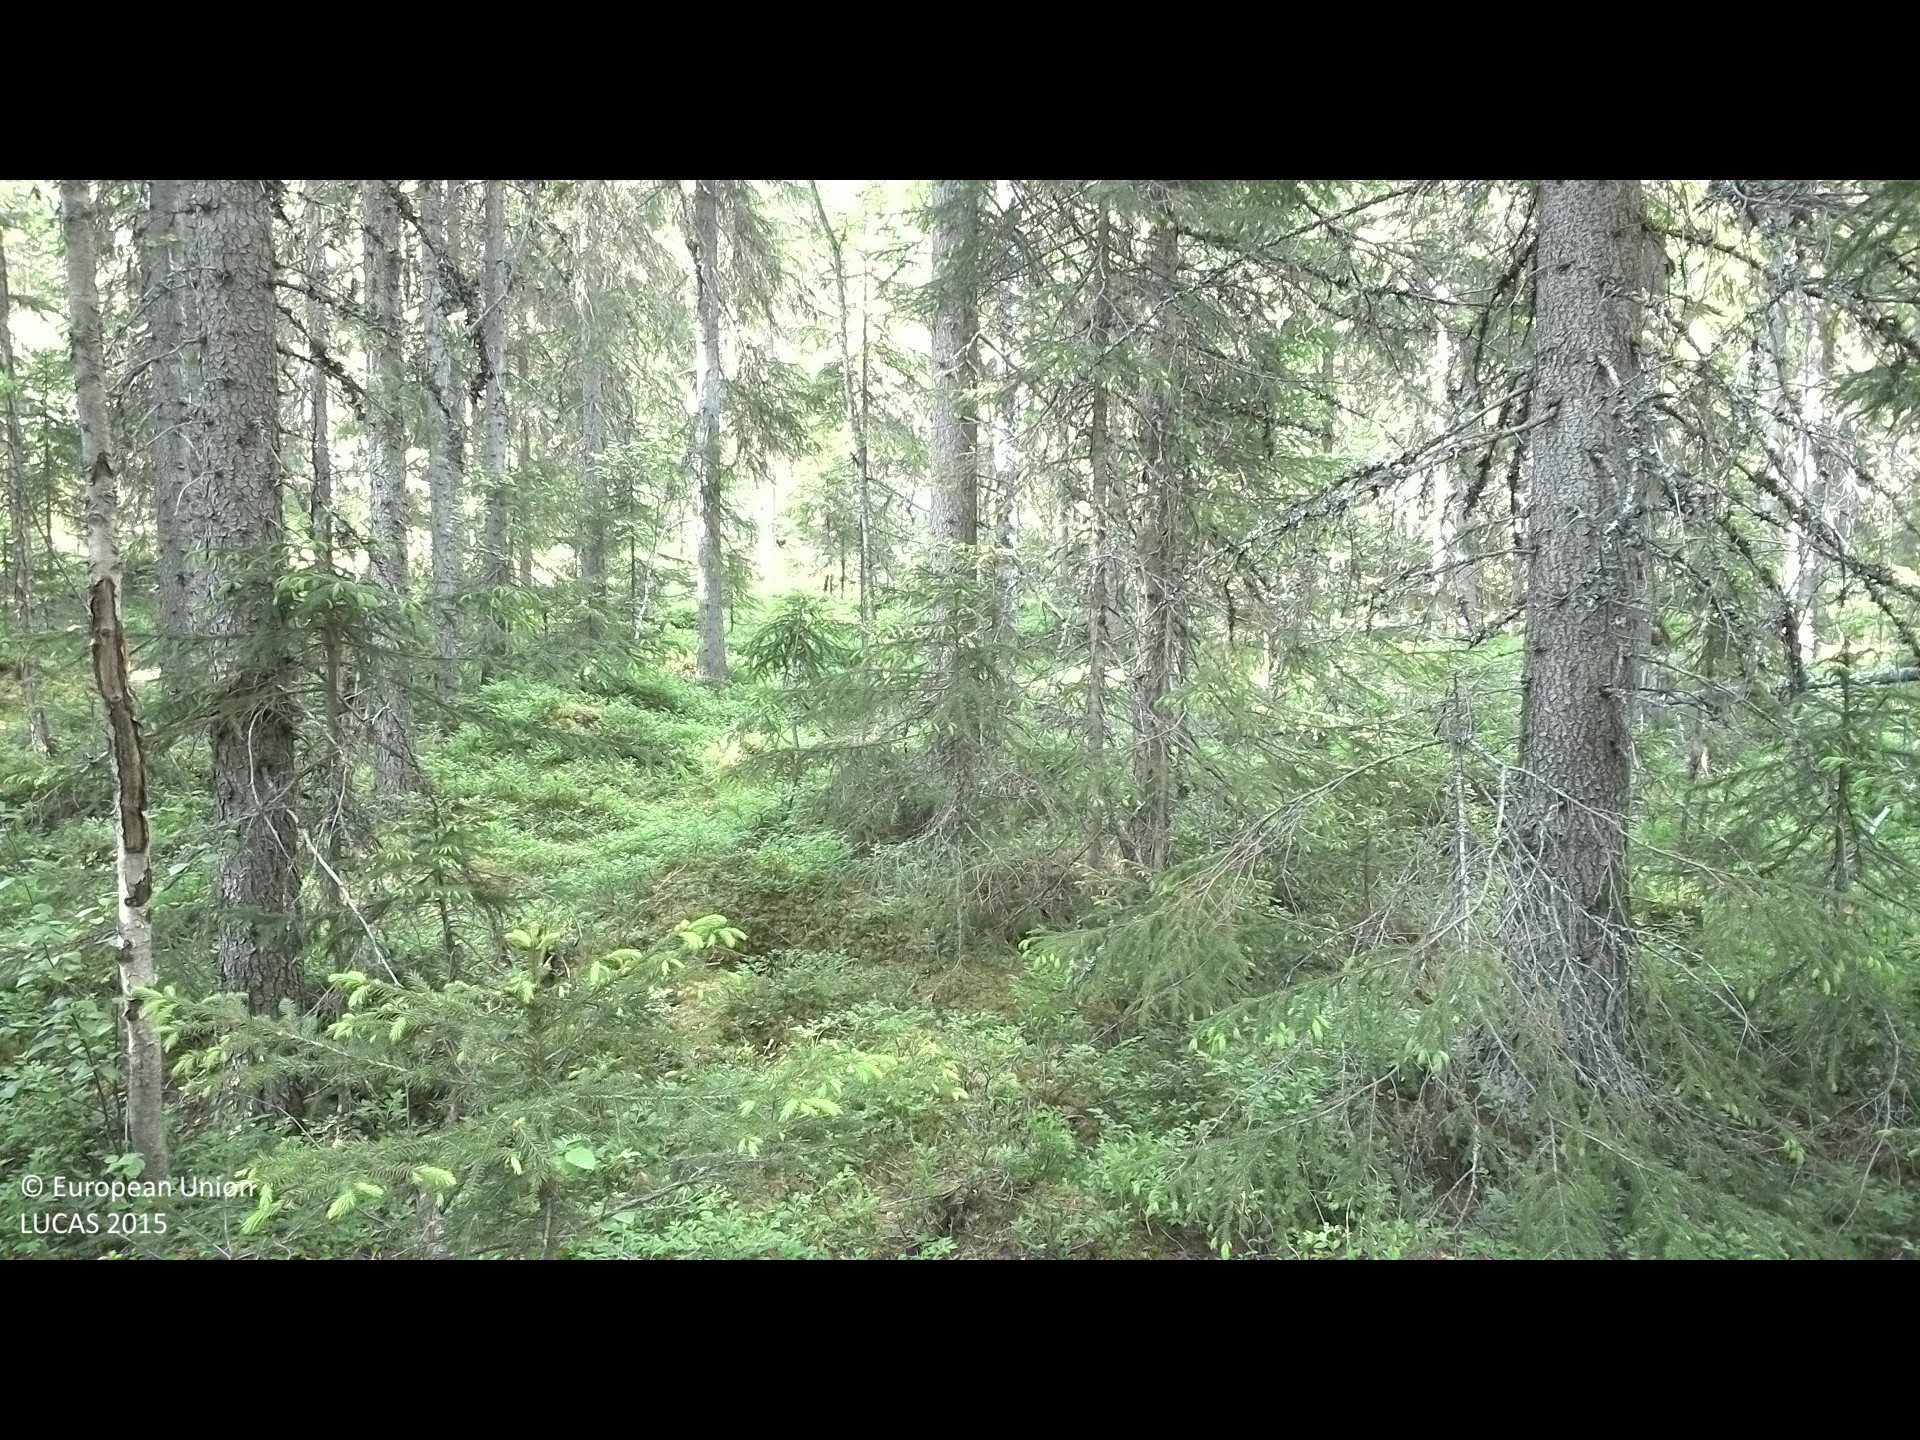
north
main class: Woodland
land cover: Spruce dominated mixed woodland
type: boreal forest
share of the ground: 50 - 75 %
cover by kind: coniferous forest trees 45 %, shrubs 30 %, broadleaved forest trees 15 %, lichens and mosses 10 %
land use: Forestry
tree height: > 5 m
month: June
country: SE
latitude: 62.0016
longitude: 16.0728
